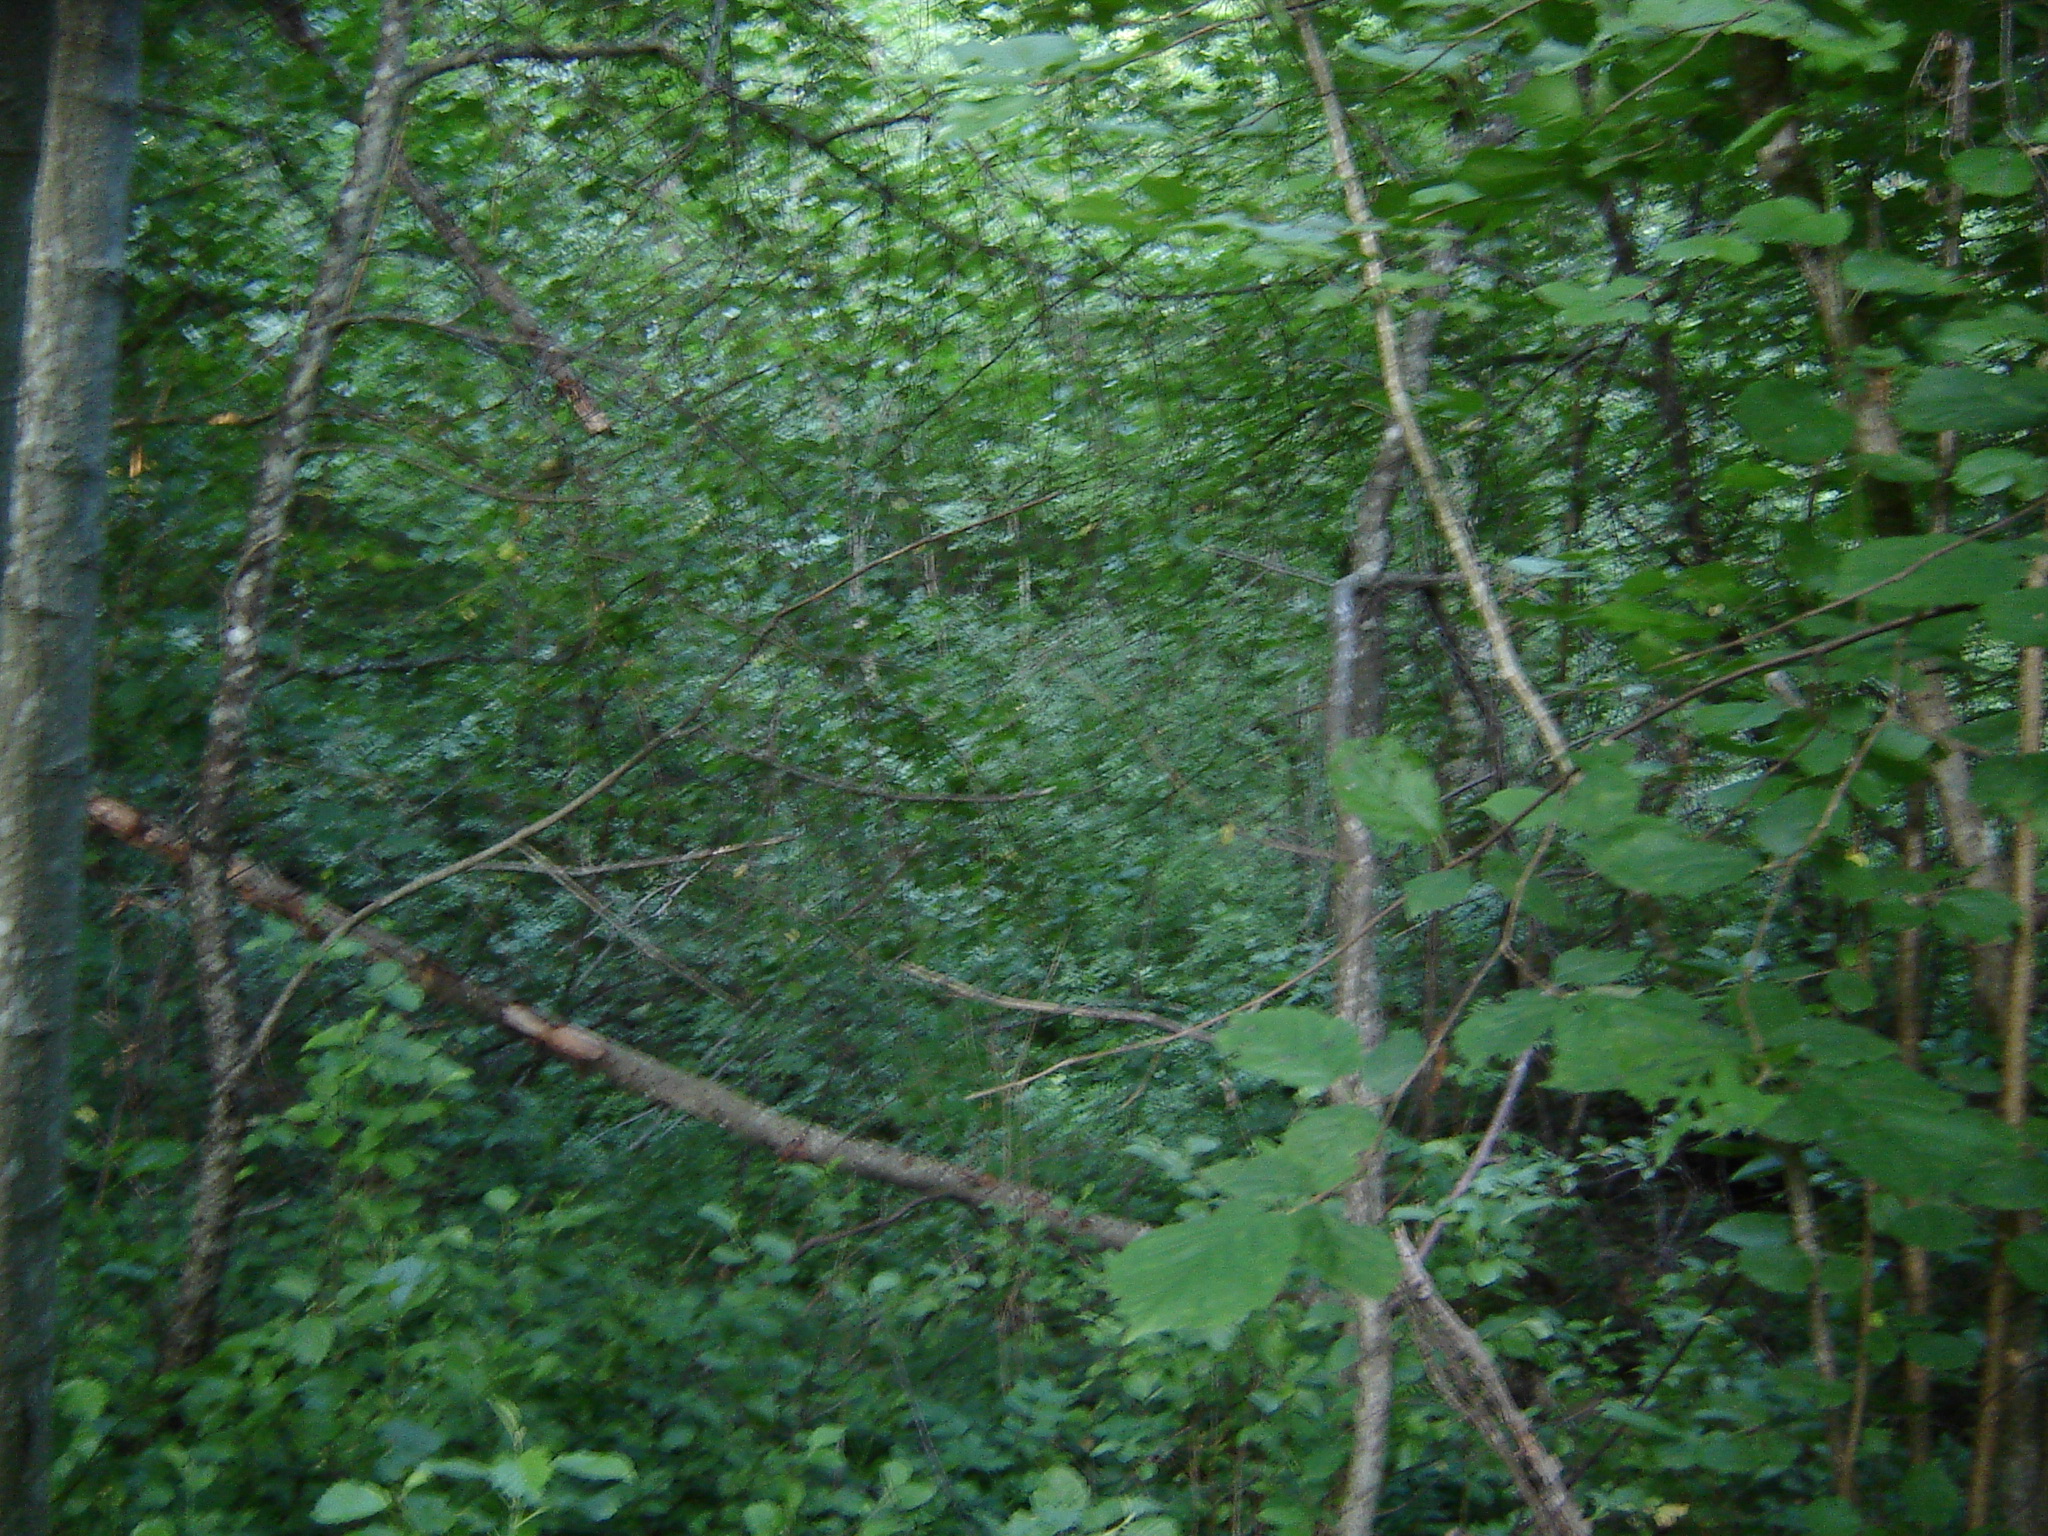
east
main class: Woodland
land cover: Broadleaved woodland
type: non-riverine alder, birch or aspen forest
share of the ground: > 75 %
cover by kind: broadleaved forest trees 100 %
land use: Forestry
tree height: > 5 m
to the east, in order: Broadleaved woodland
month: July
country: LT
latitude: 55.3999
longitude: 25.5211
